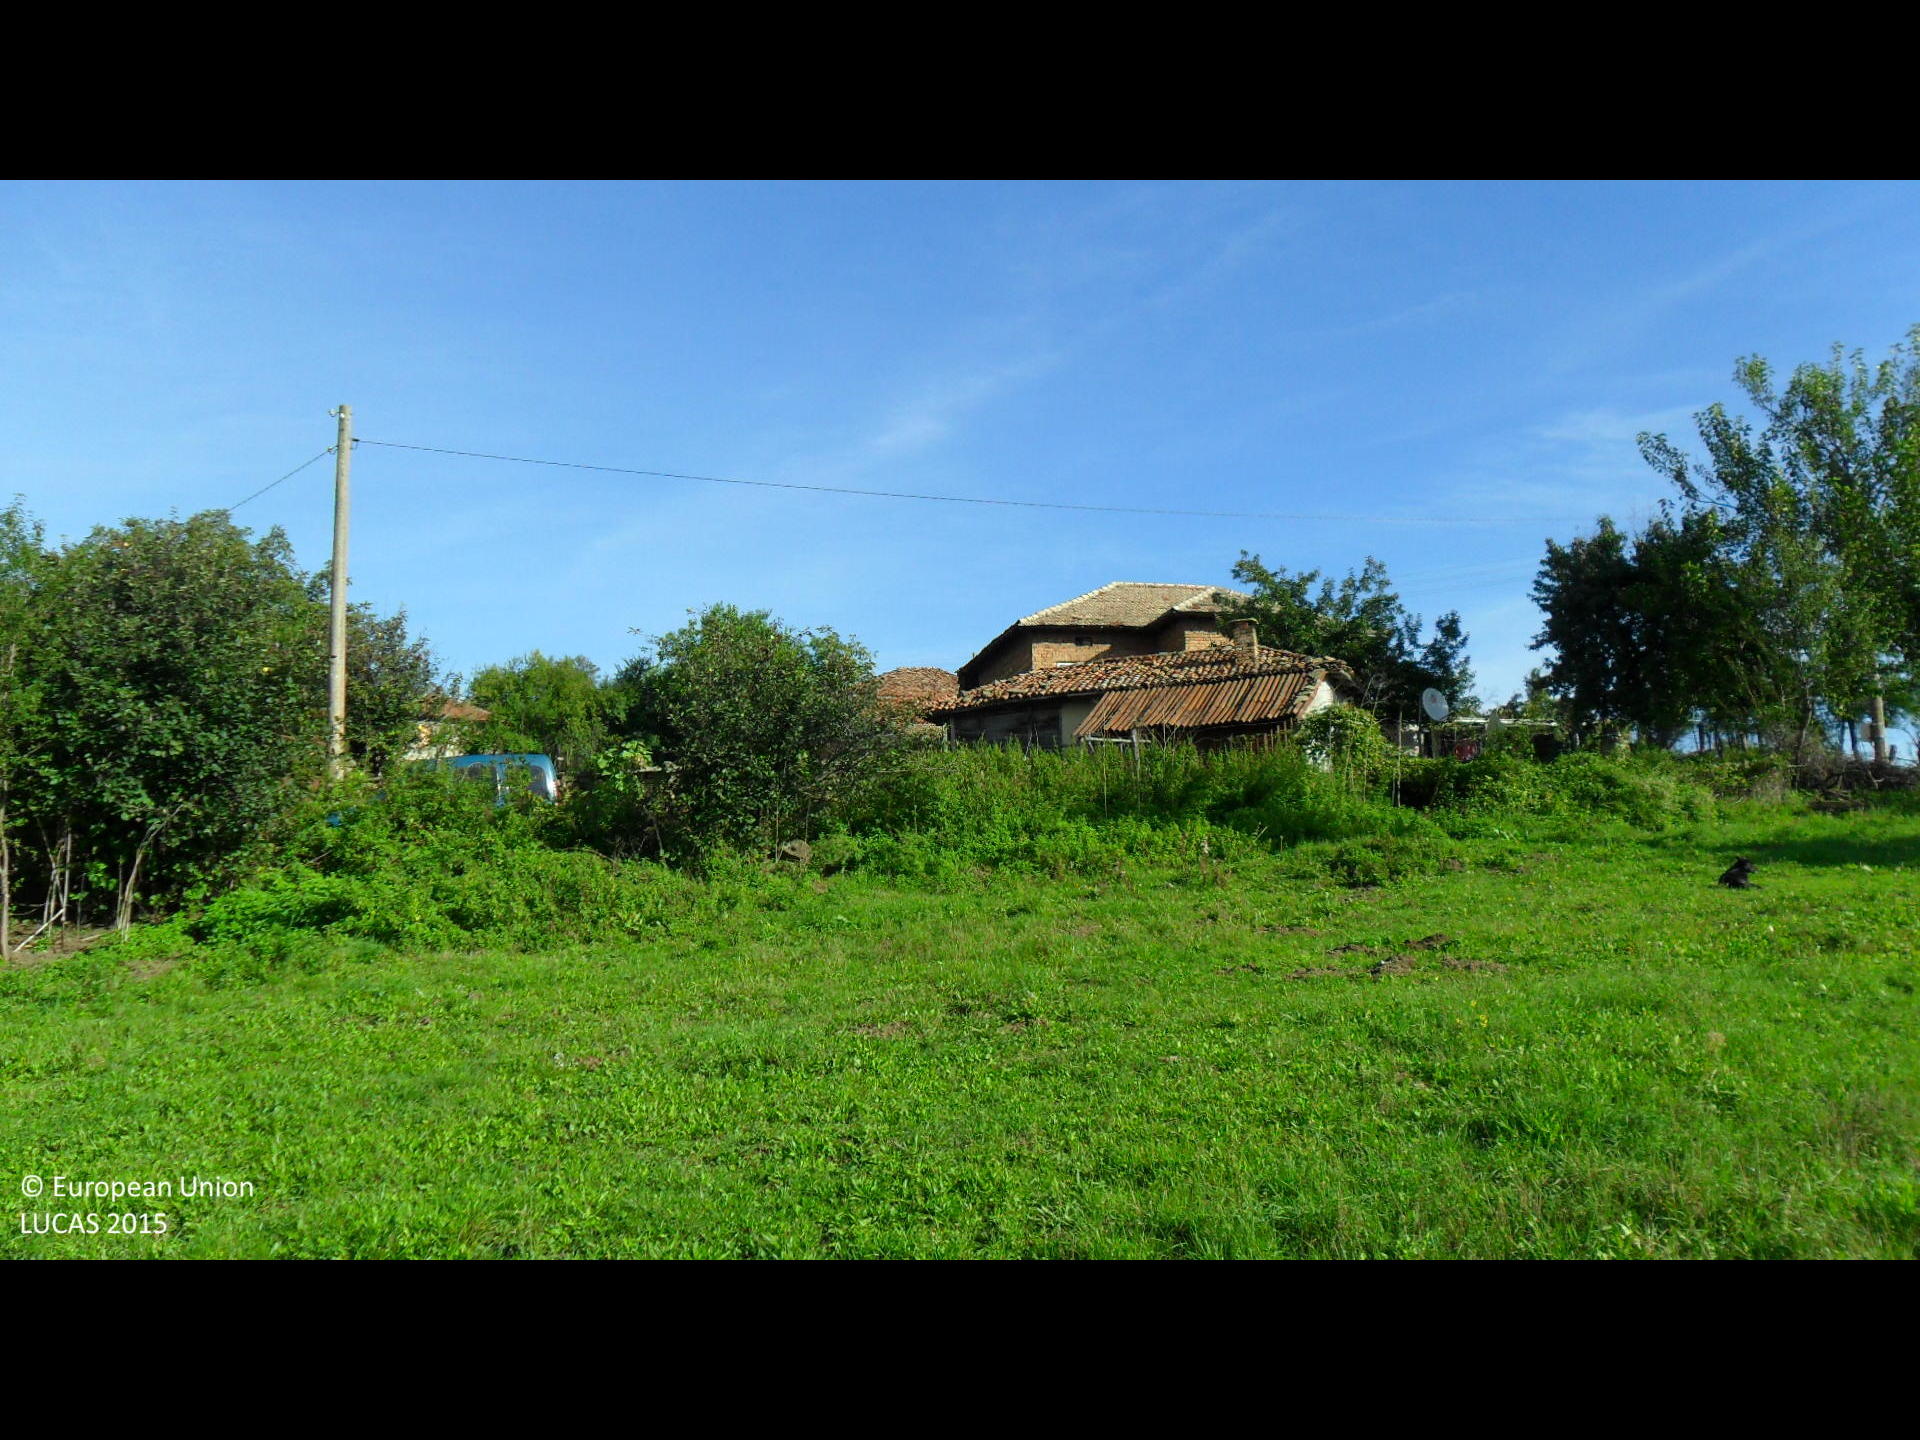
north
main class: Grassland
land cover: Grassland without tree/shrub cover
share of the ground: > 75 %
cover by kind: herbaceous plants 100 %
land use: Agriculture (excluding fallow land and kitchen gardens)
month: October
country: BG
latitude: 43.0746
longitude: 26.2689
